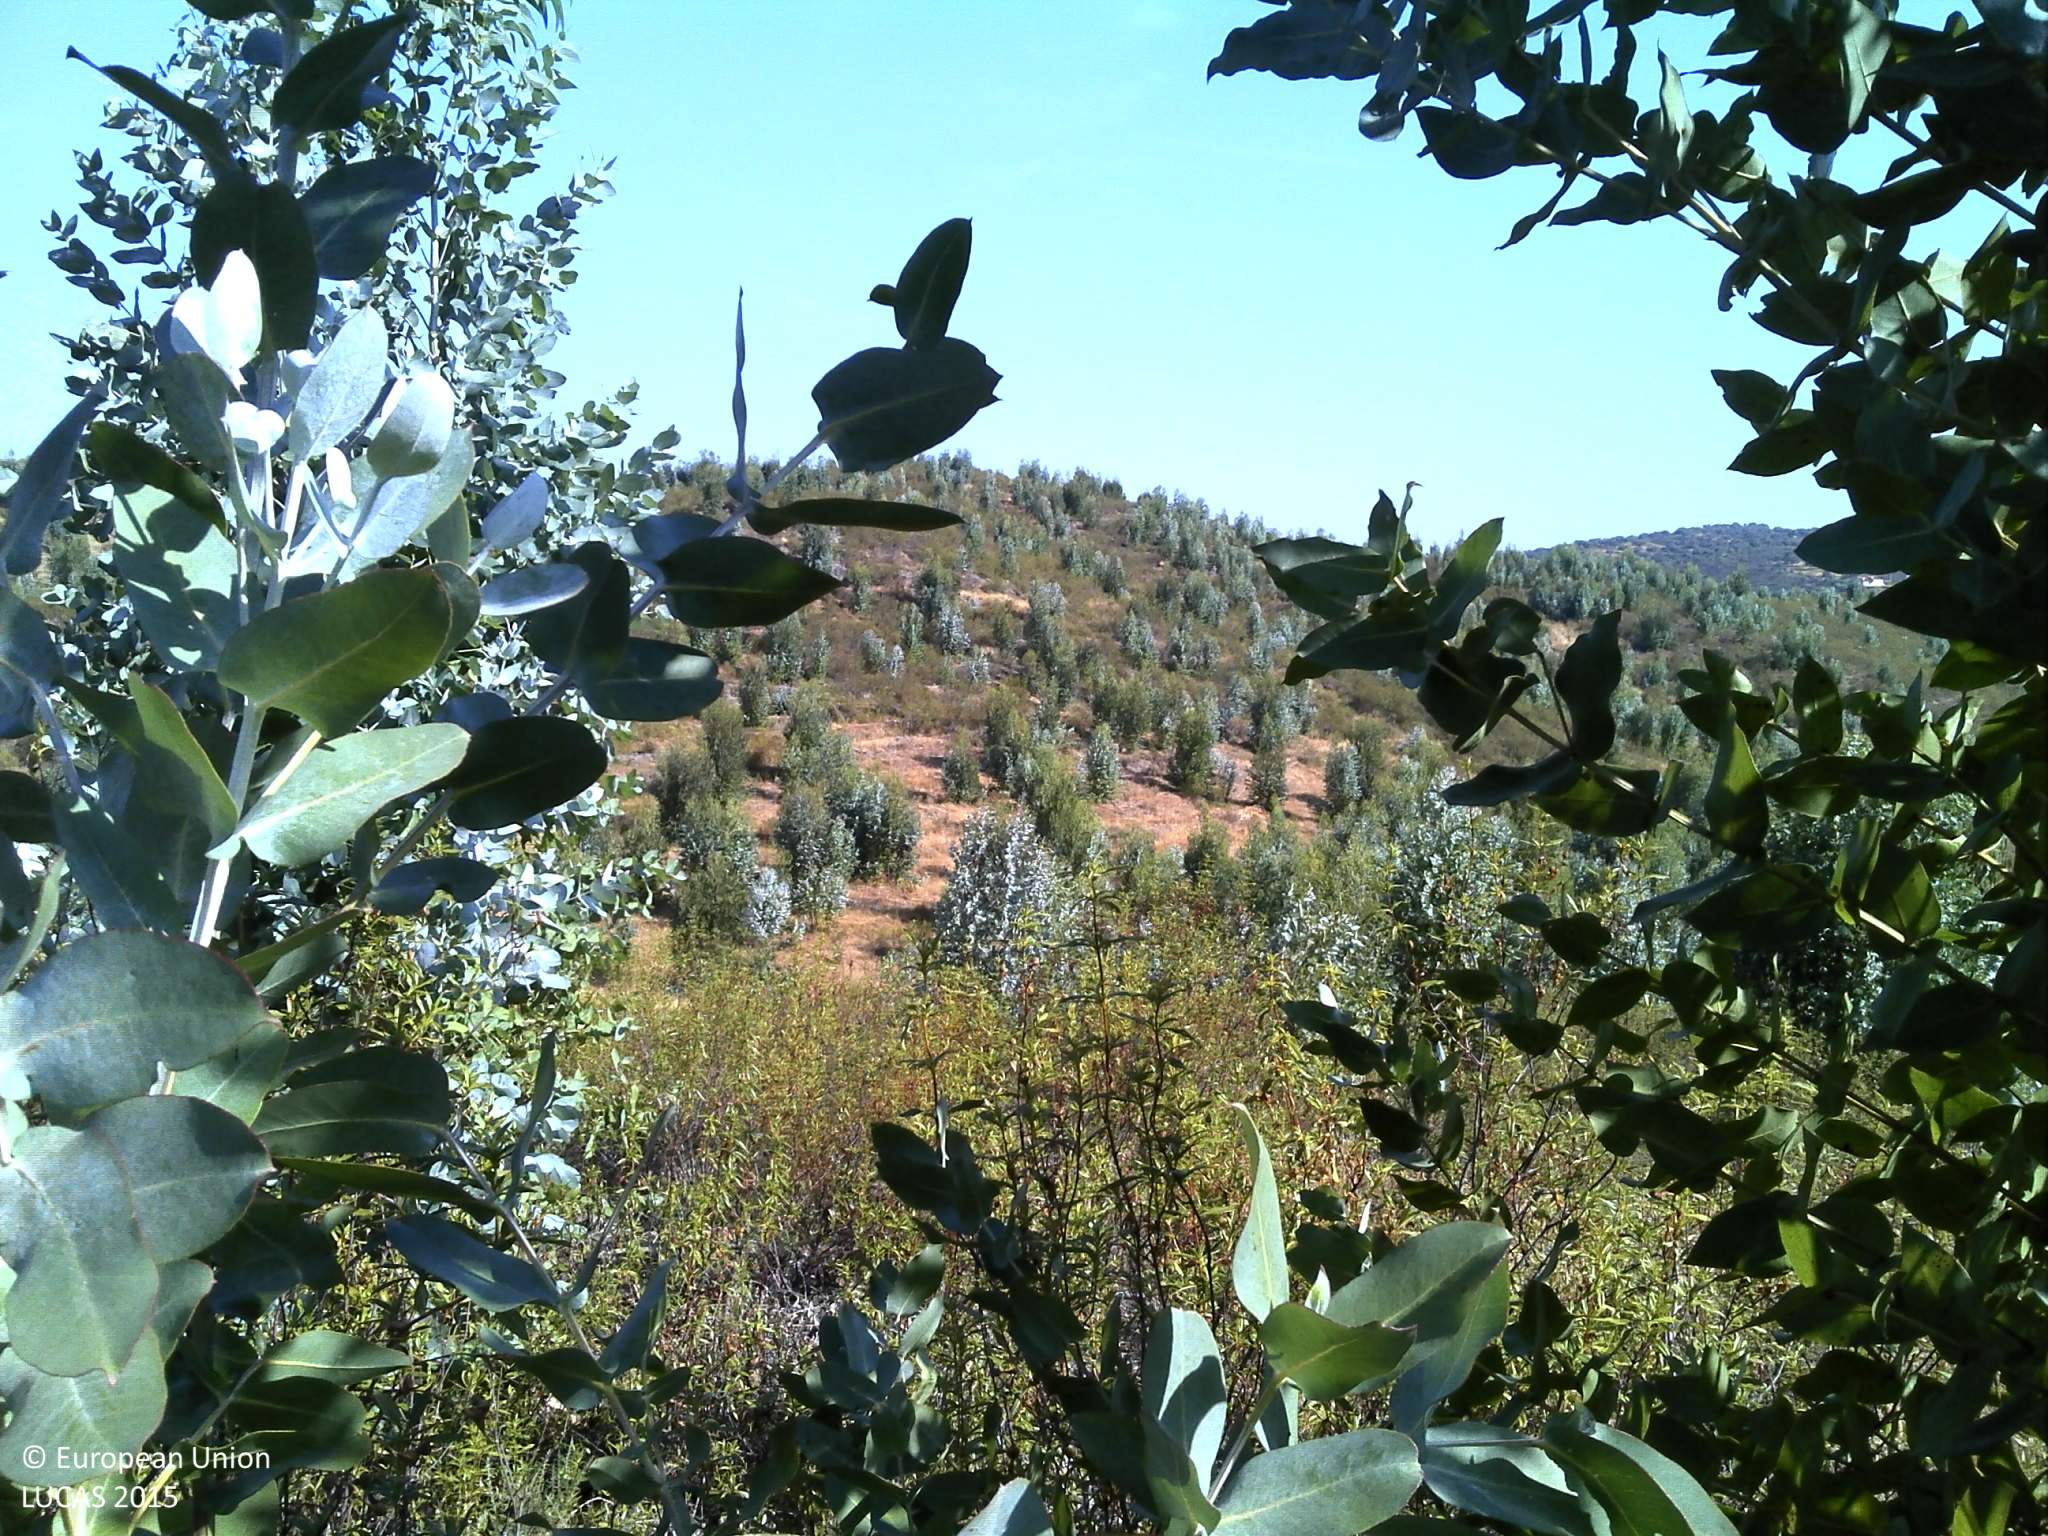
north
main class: Woodland
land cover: Broadleaved woodland
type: exotic forest
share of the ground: 25 - 50 %
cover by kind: shrubs 40 %, broadleaved forest trees 25 %, herbaceous plants 15 %, consolidated bare surface 10 %, unconsolidated bare surface 10 %
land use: Forestry
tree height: < 5 m
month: July
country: PT
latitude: 38.5979
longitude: -7.4473
